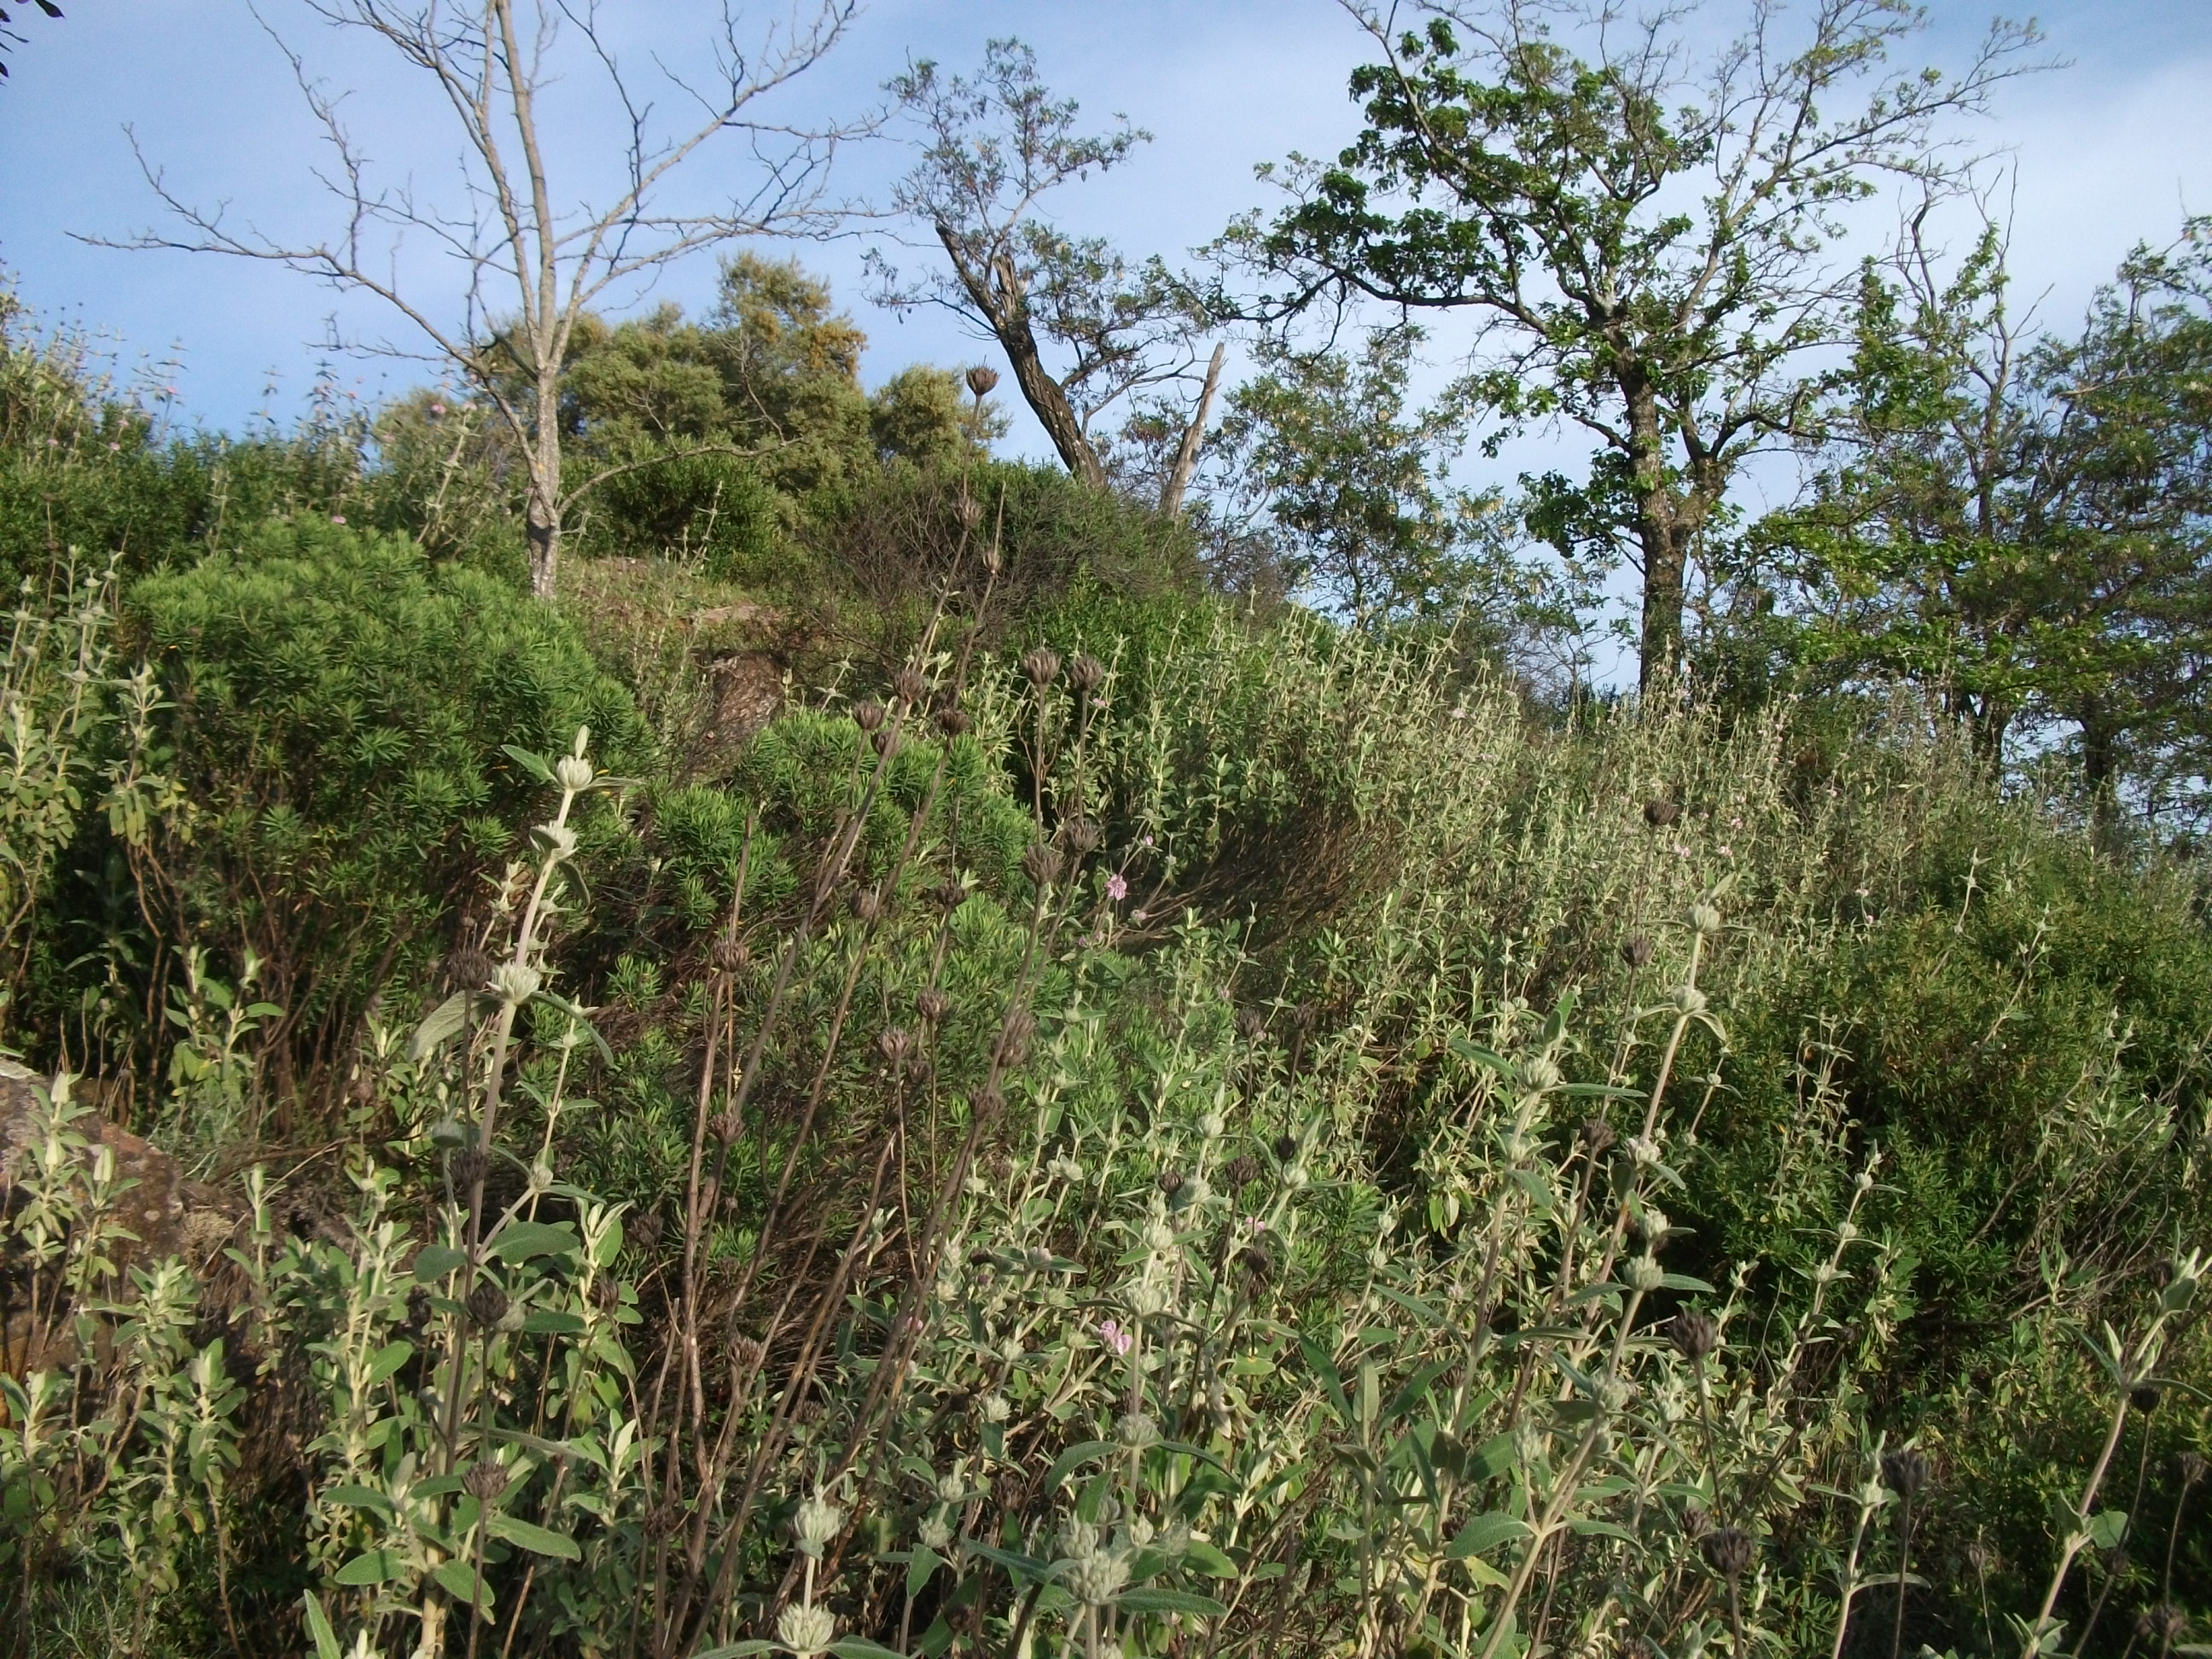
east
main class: Woodland
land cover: Other mixed woodland
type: coniferous forest of the mediterranean region
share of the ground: 25 - 50 %
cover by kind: shrubs 45 %, coniferous forest trees 25 %, broadleaved forest trees 20 %, herbaceous plants 10 %
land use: Semi-natural and natural areas not in use
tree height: > 5 m
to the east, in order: Other mixed woodland; Broadleaved woodland; Shrubland with sparse tree cover; Dry stone walls; Broadleaved woodland; Dry stone walls; Broadleaved woodland; Rocks and stones; Spontaneously vegetated surfaces
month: April
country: ES
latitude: 37.8894
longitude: -6.5652
